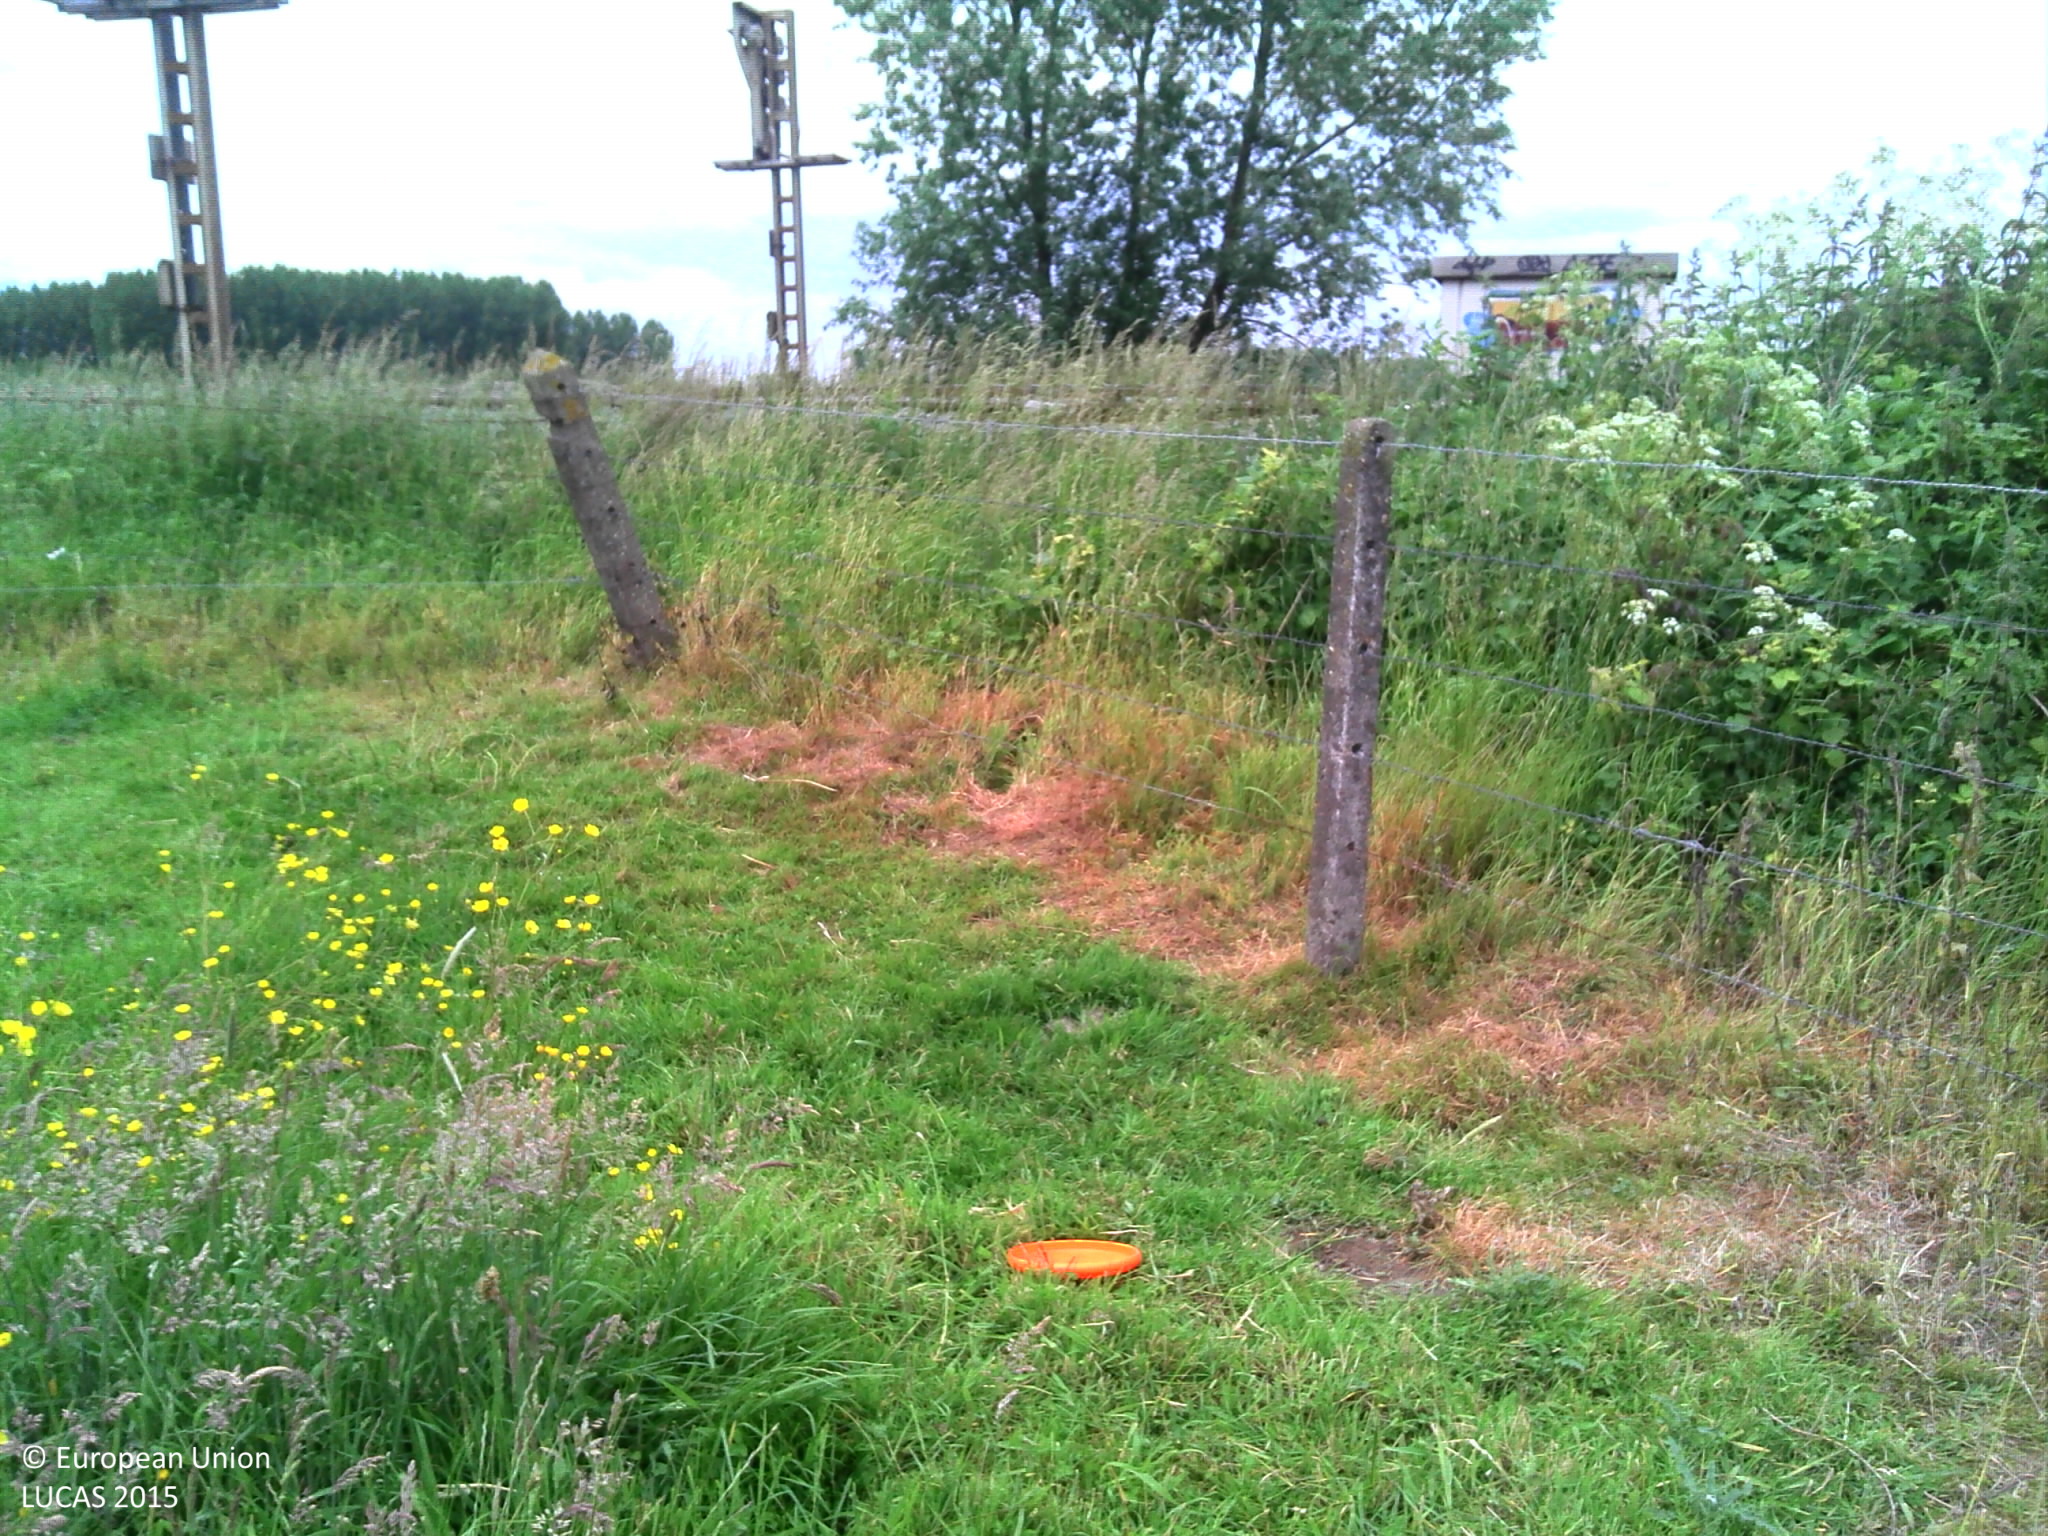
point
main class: Grassland
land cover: Grassland without tree/shrub cover
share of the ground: > 75 %
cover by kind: herbaceous plants 100 %
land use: Agriculture (excluding fallow land and kitchen gardens)
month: June
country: BE
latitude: 50.9101
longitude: 4.0066
